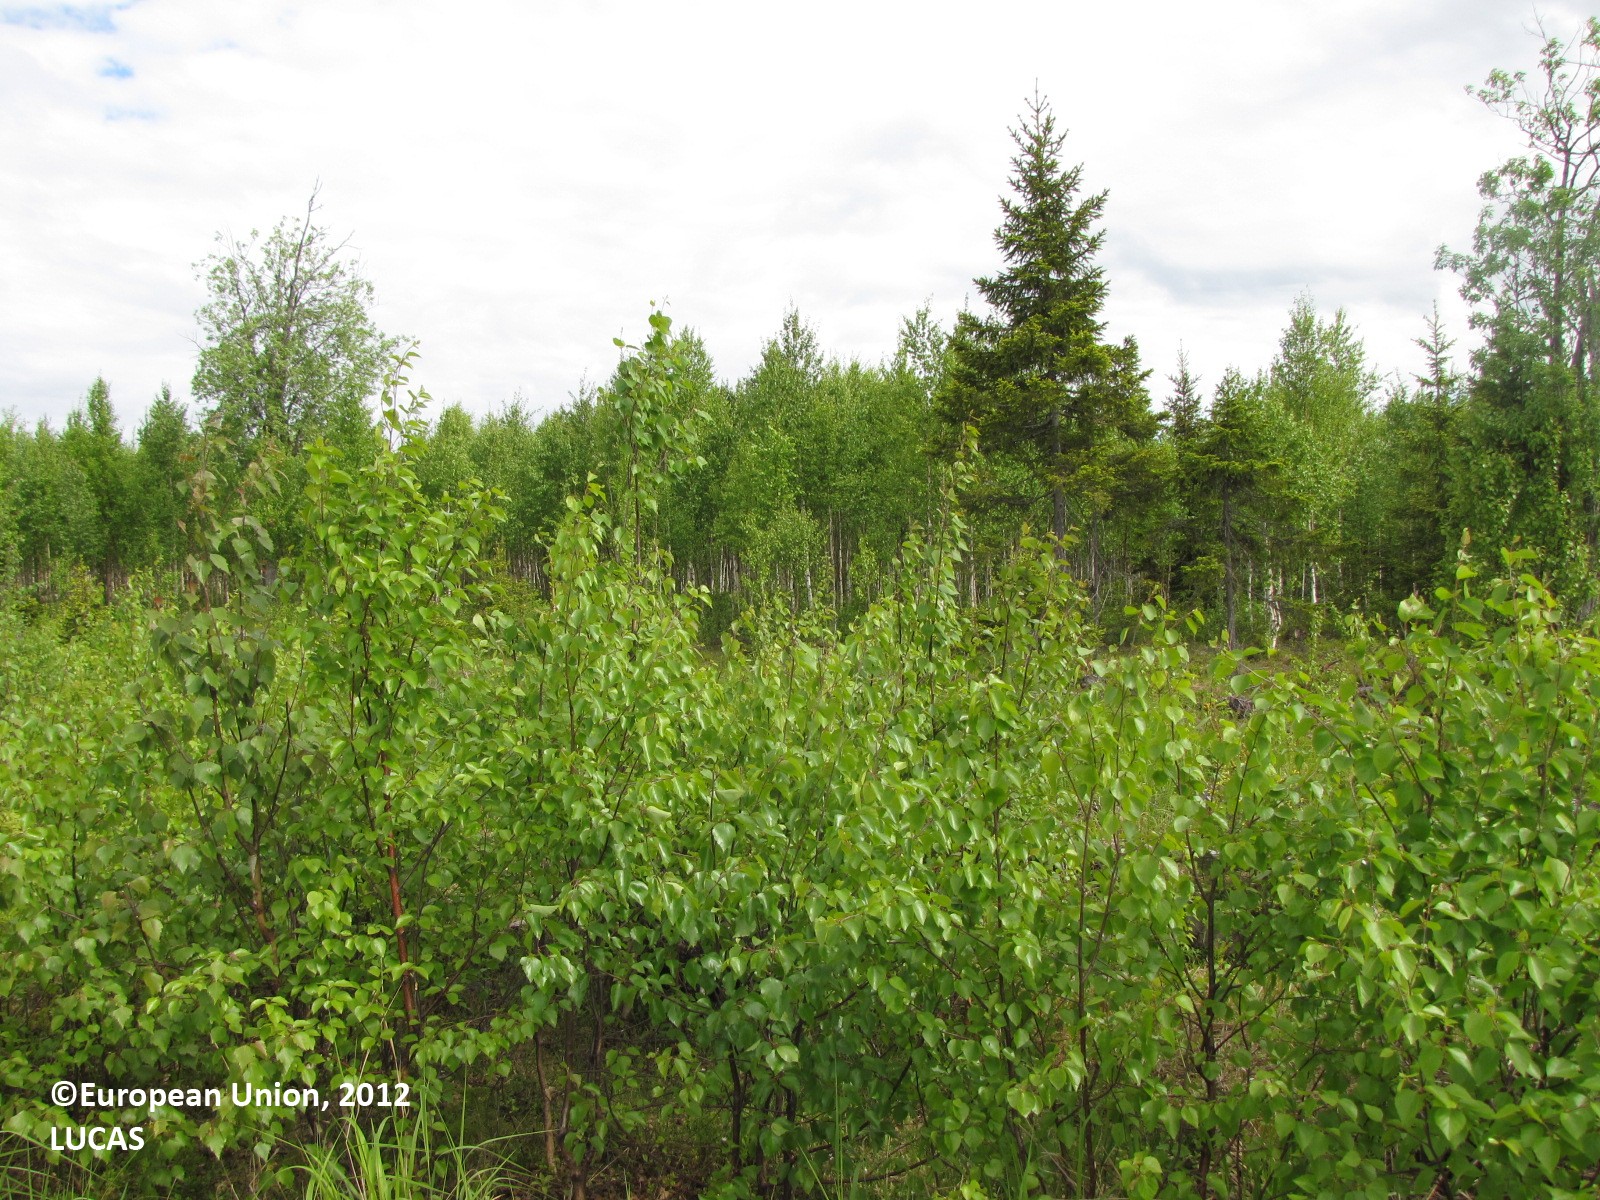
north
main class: Woodland
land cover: Broadleaved woodland
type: boreal forest
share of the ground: 25 - 50 %
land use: Forestry
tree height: < 5 m
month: June
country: FI
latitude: 66.0574
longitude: 24.6499
